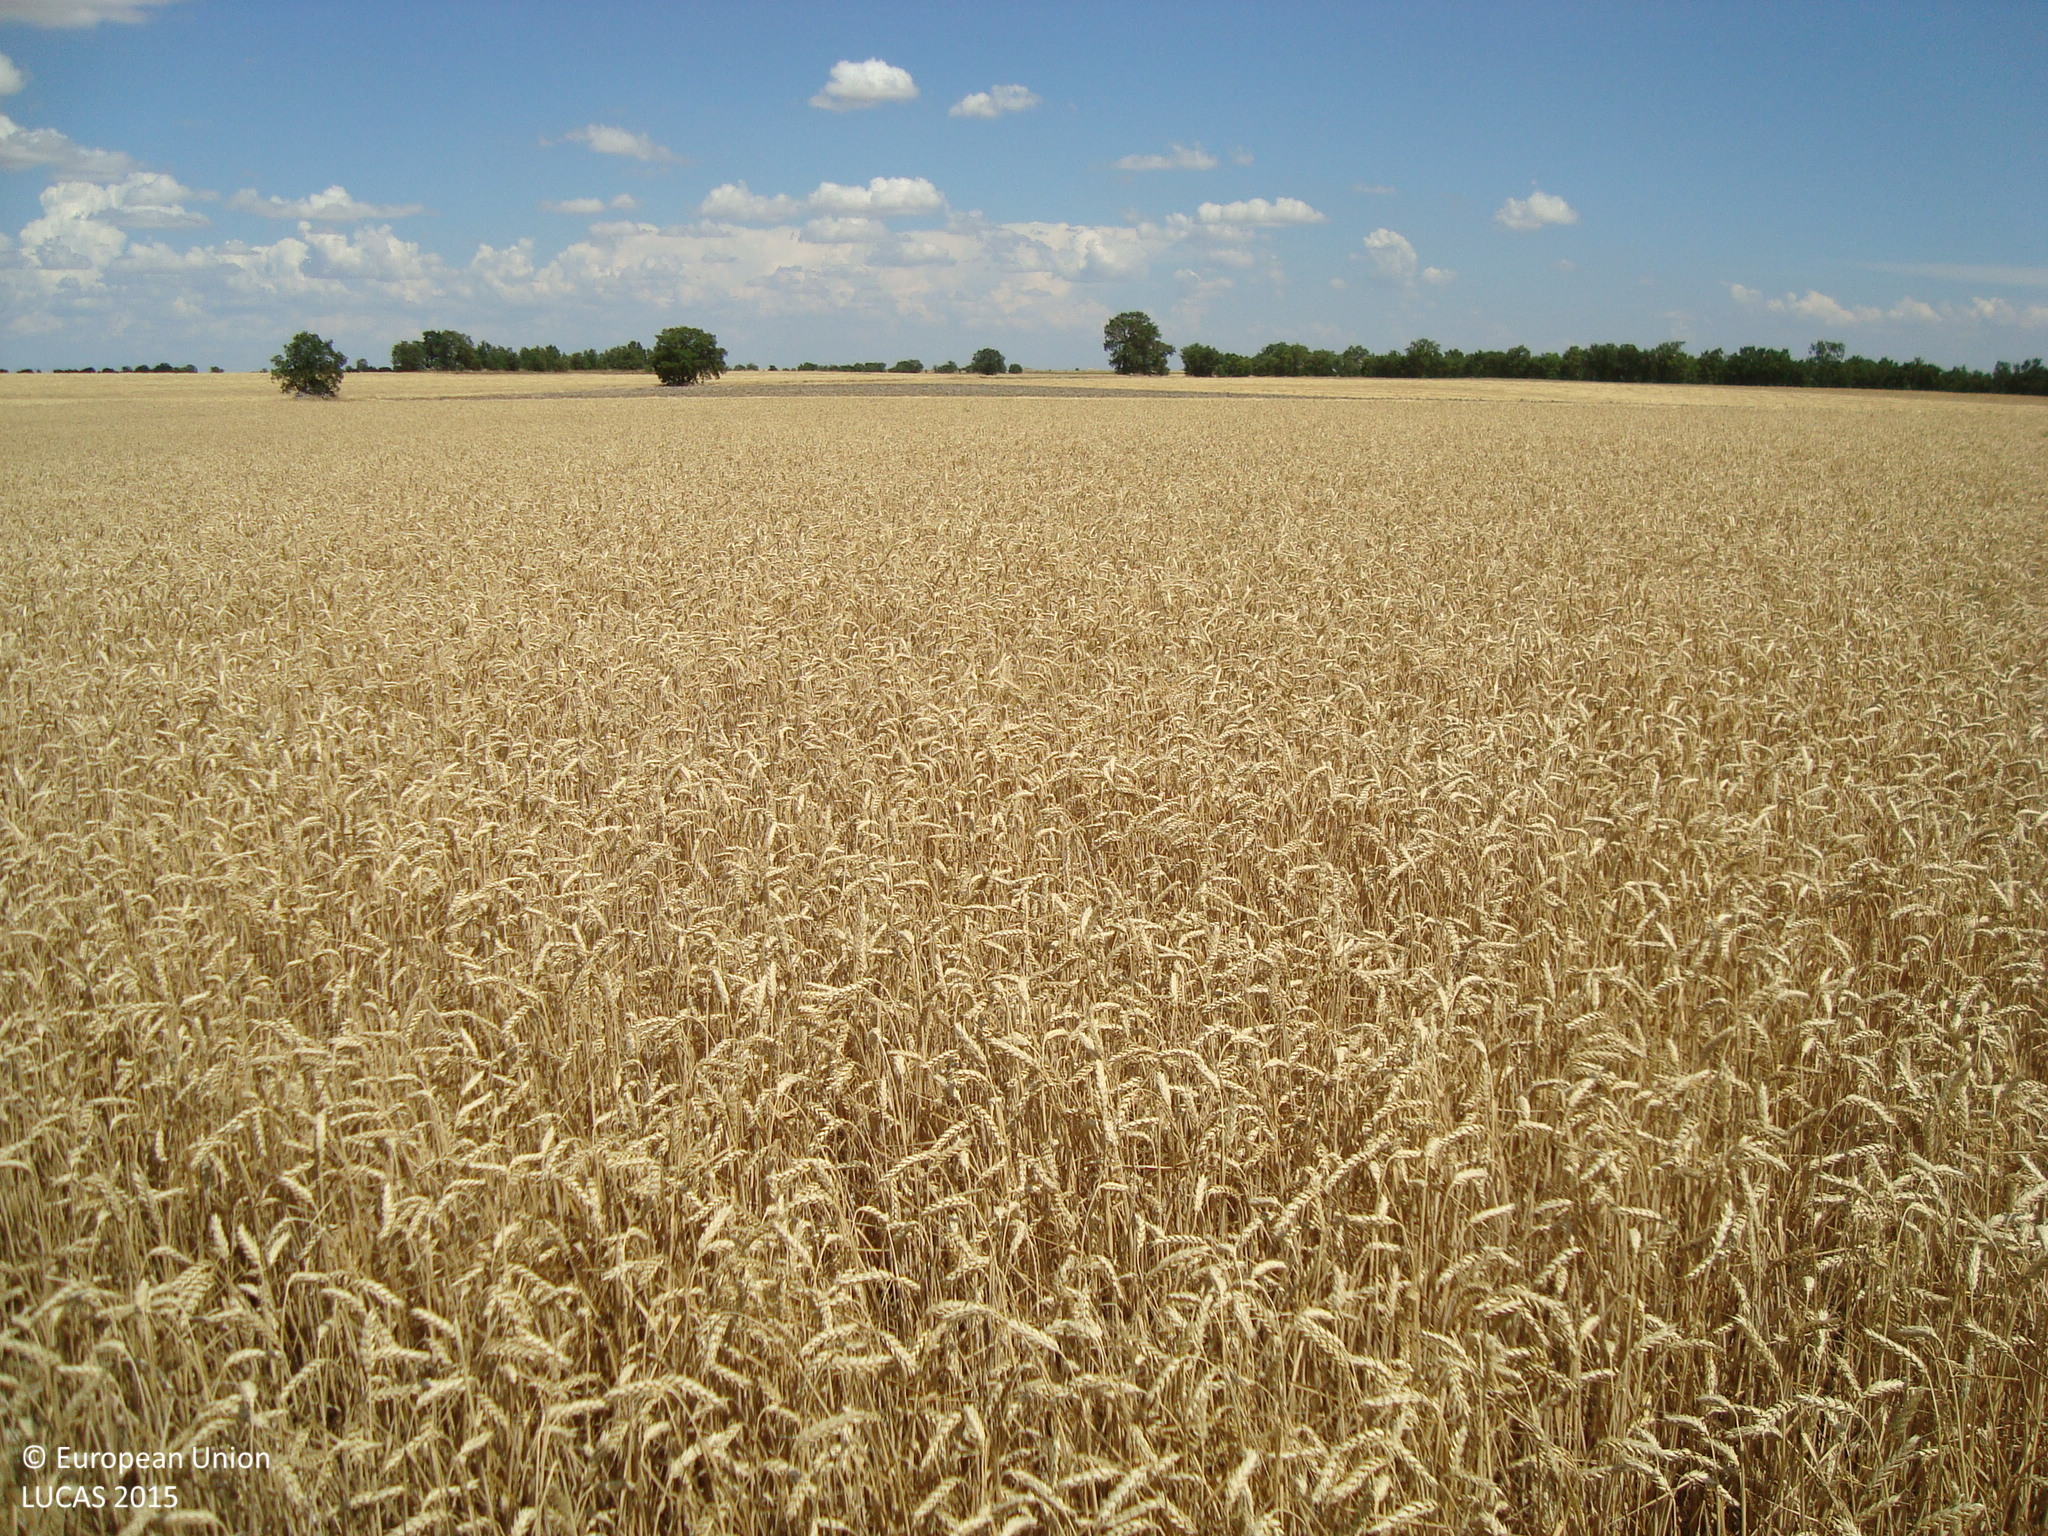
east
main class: Cropland
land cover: Common wheat
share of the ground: > 75 %
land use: Agriculture (excluding fallow land and kitchen gardens)
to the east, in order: Common wheat; Other bare soil; Barley
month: July
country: ES
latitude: 41.7433
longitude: -4.0436
